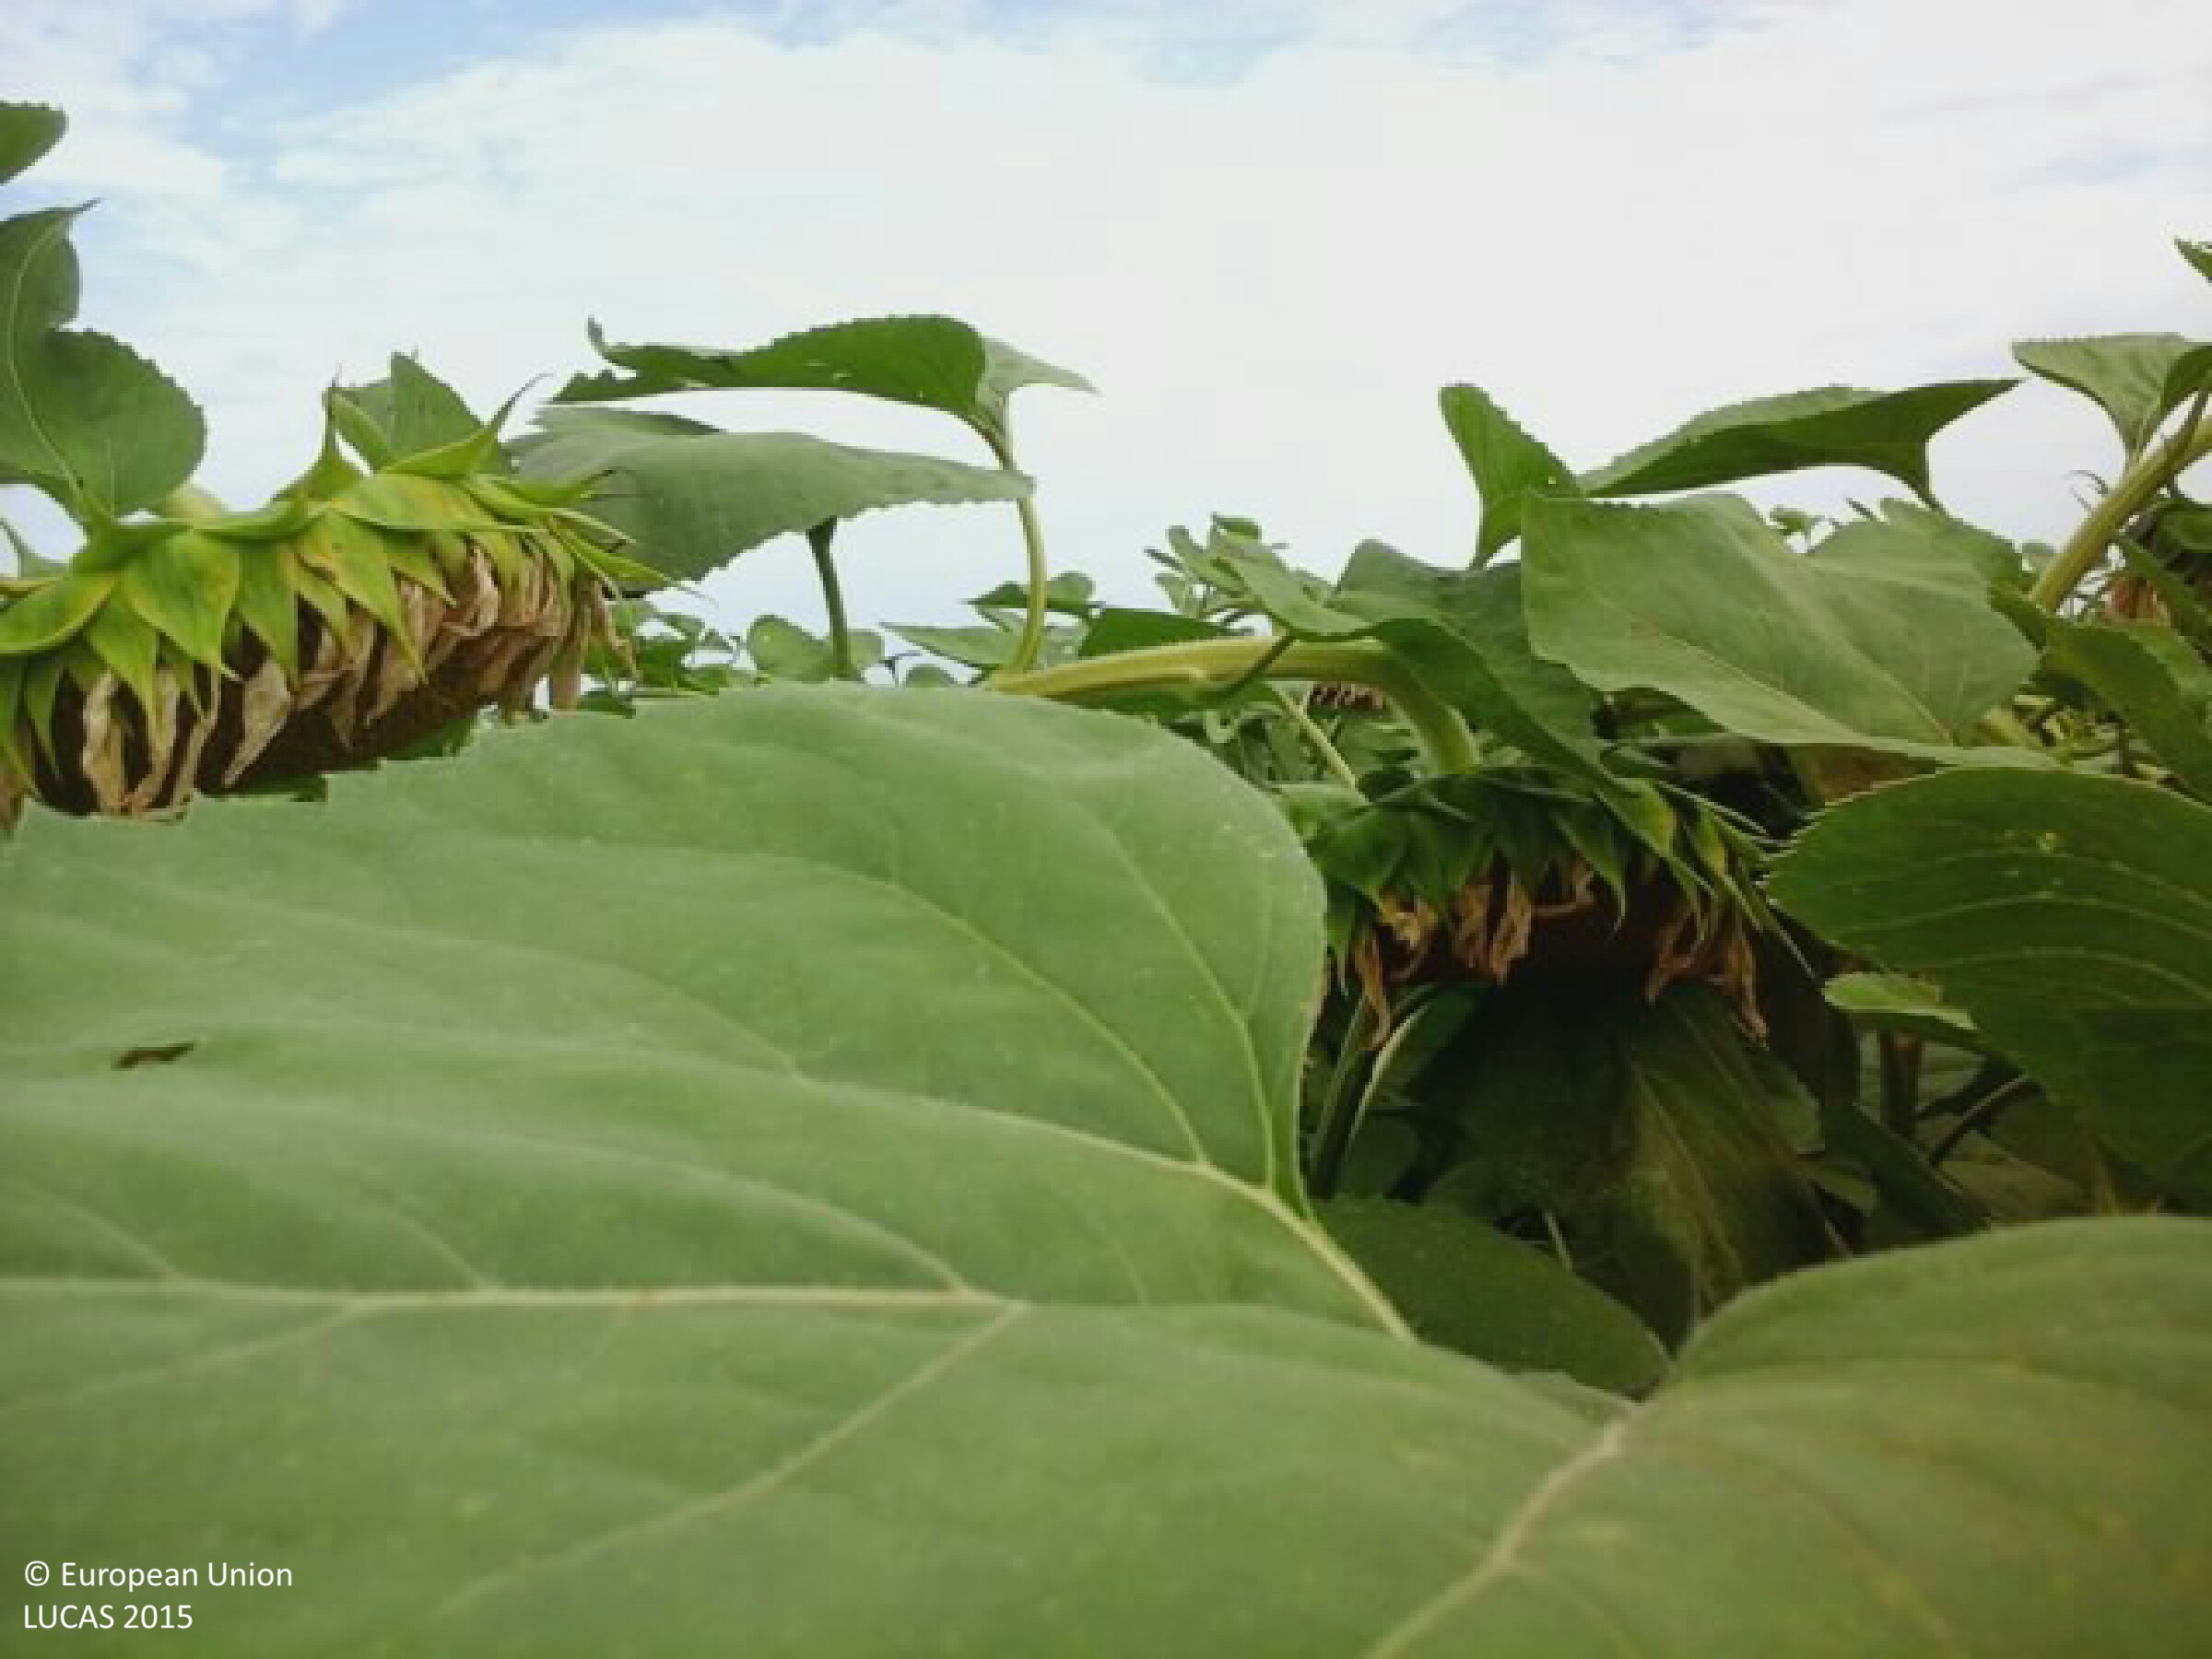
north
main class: Cropland
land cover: Sunflower
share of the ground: > 75 %
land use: Agriculture (excluding fallow land and kitchen gardens)
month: July
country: HU
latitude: 46.0041
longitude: 19.0384
